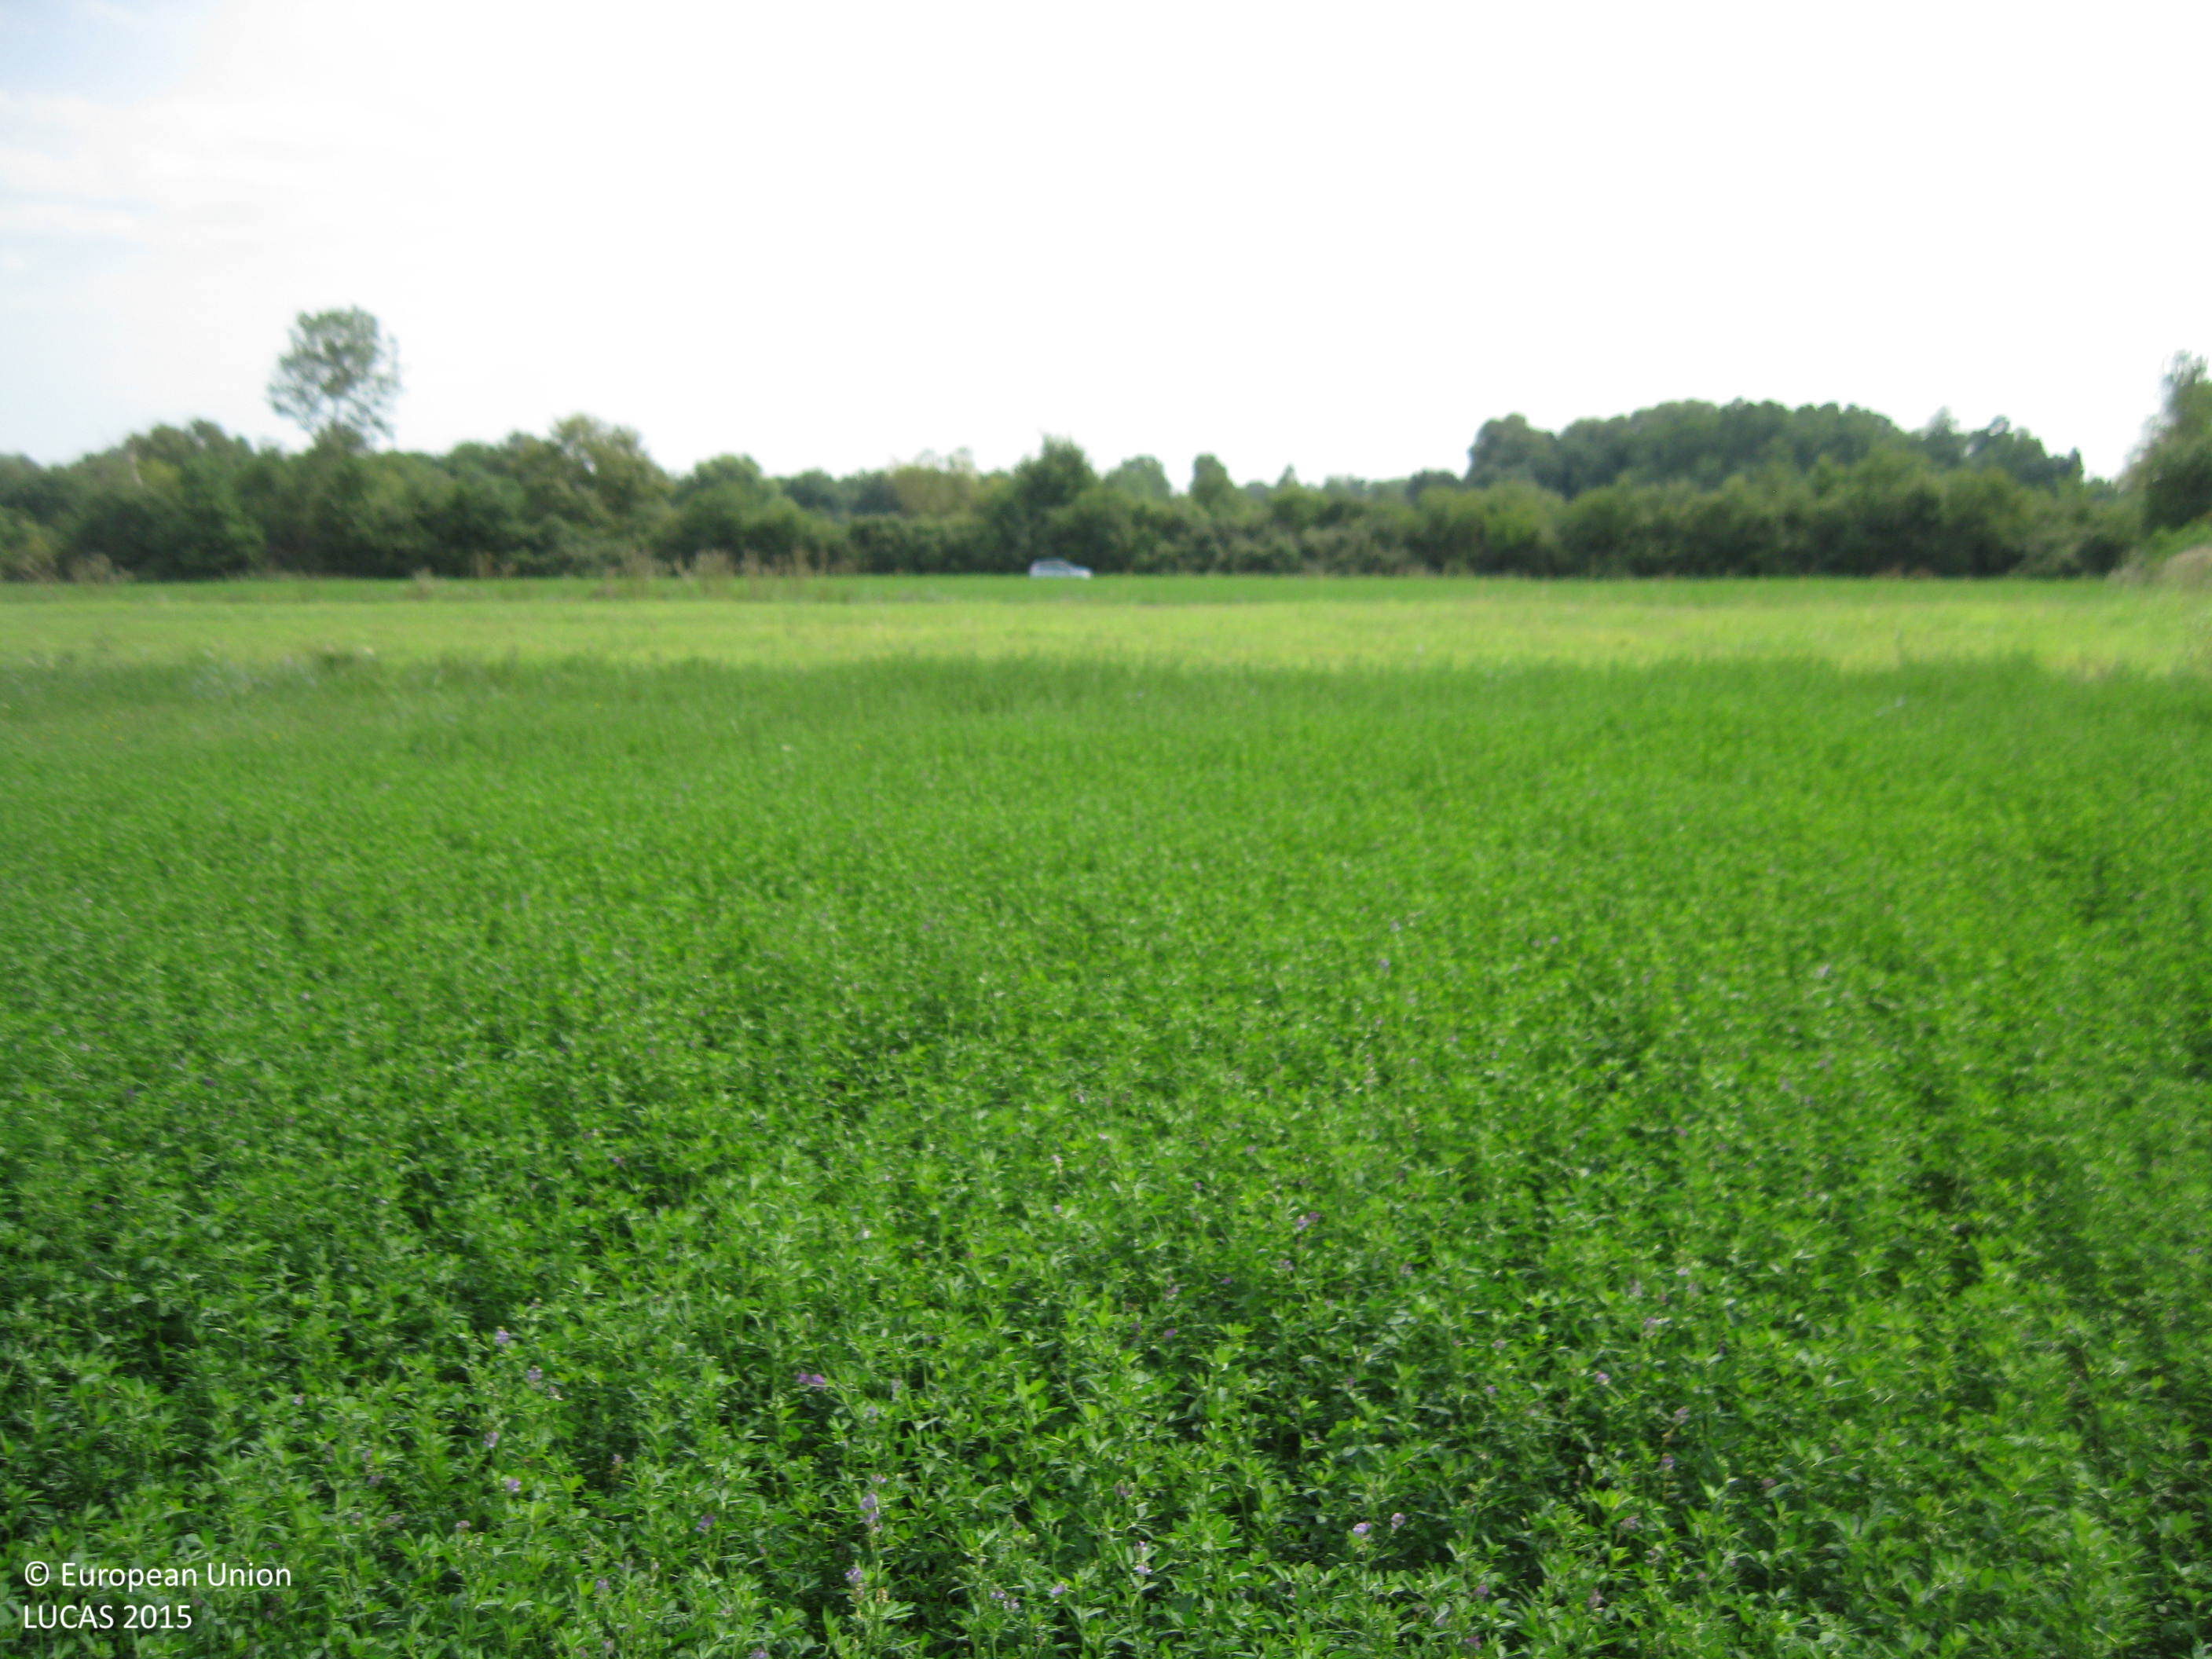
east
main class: Cropland
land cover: Lucerne
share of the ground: > 75 %
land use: Agriculture (excluding fallow land and kitchen gardens)
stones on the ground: < 10 %
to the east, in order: Lucerne; Grass margins; Common wheat; Grass margins; Lucerne; Grass margins; Broadleaved woodland; Common wheat
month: September
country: BG
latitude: 42.1526
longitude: 25.1252
